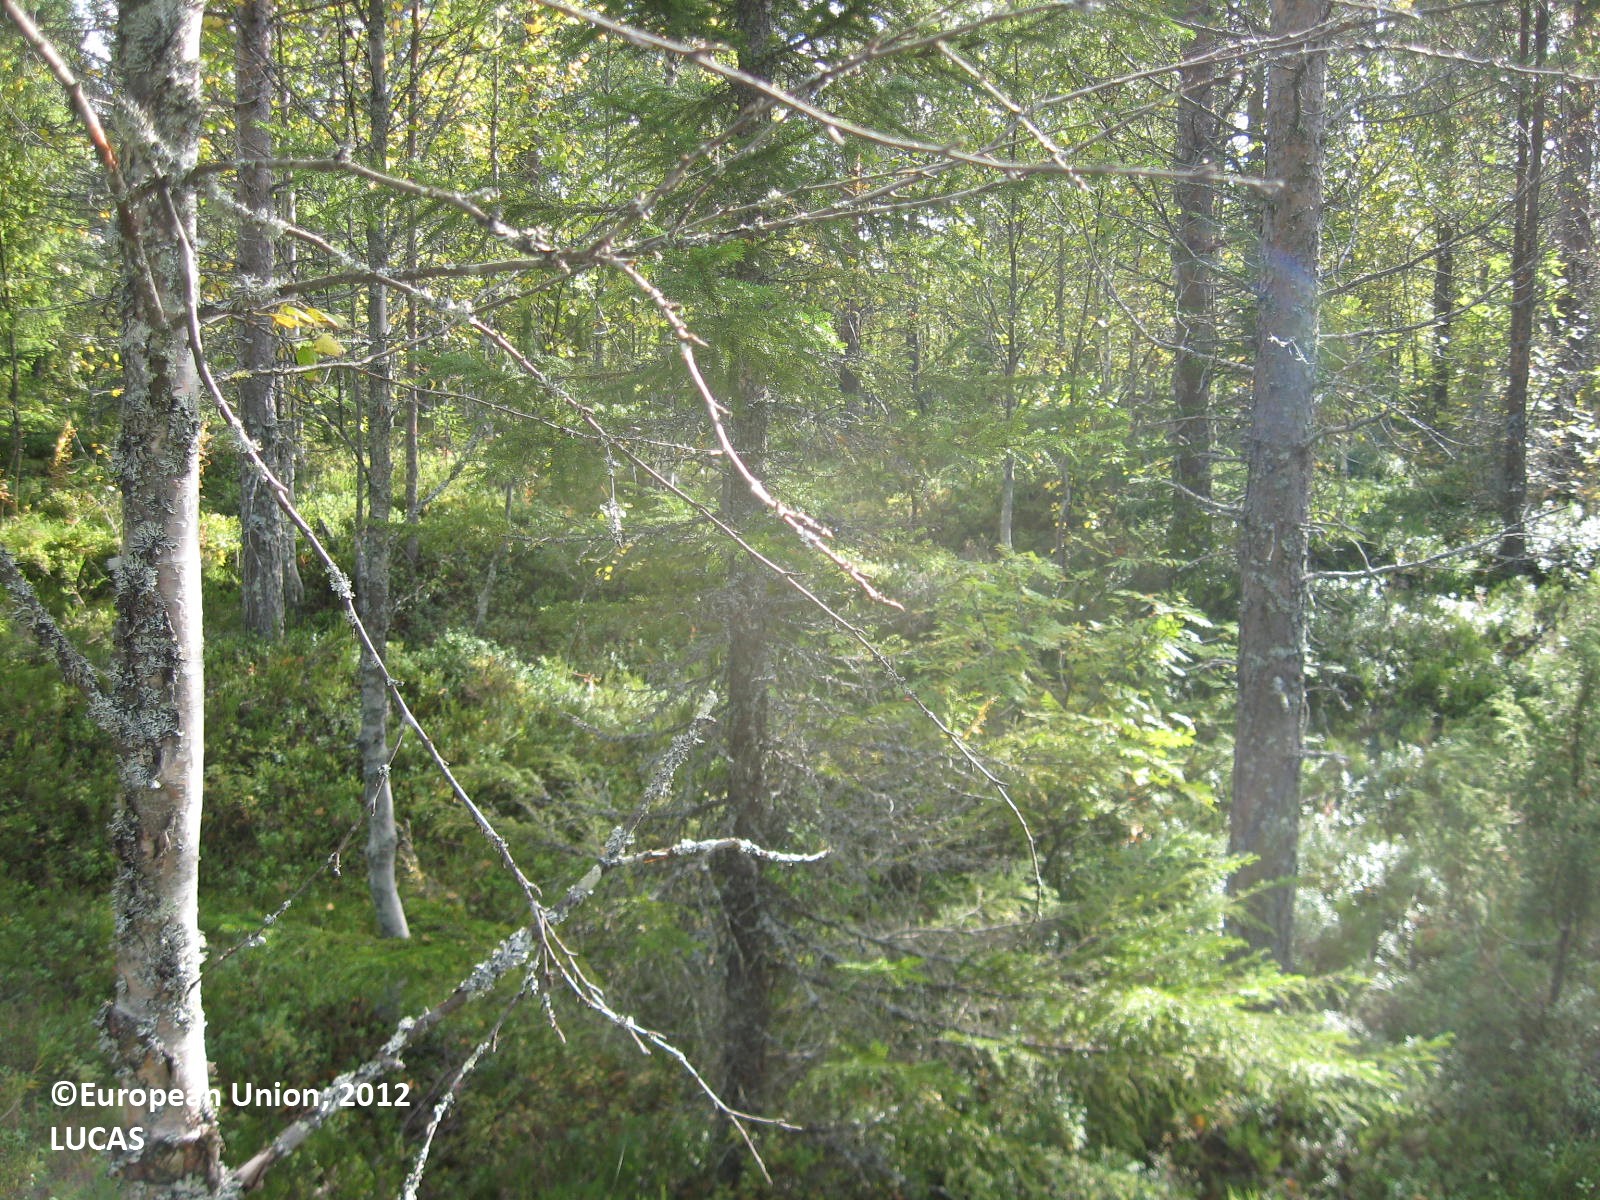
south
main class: Woodland
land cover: Pine dominated mixed woodland
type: boreal forest
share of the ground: > 75 %
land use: Forestry
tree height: > 5 m
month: August
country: FI
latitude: 63.8474
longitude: 29.6061
